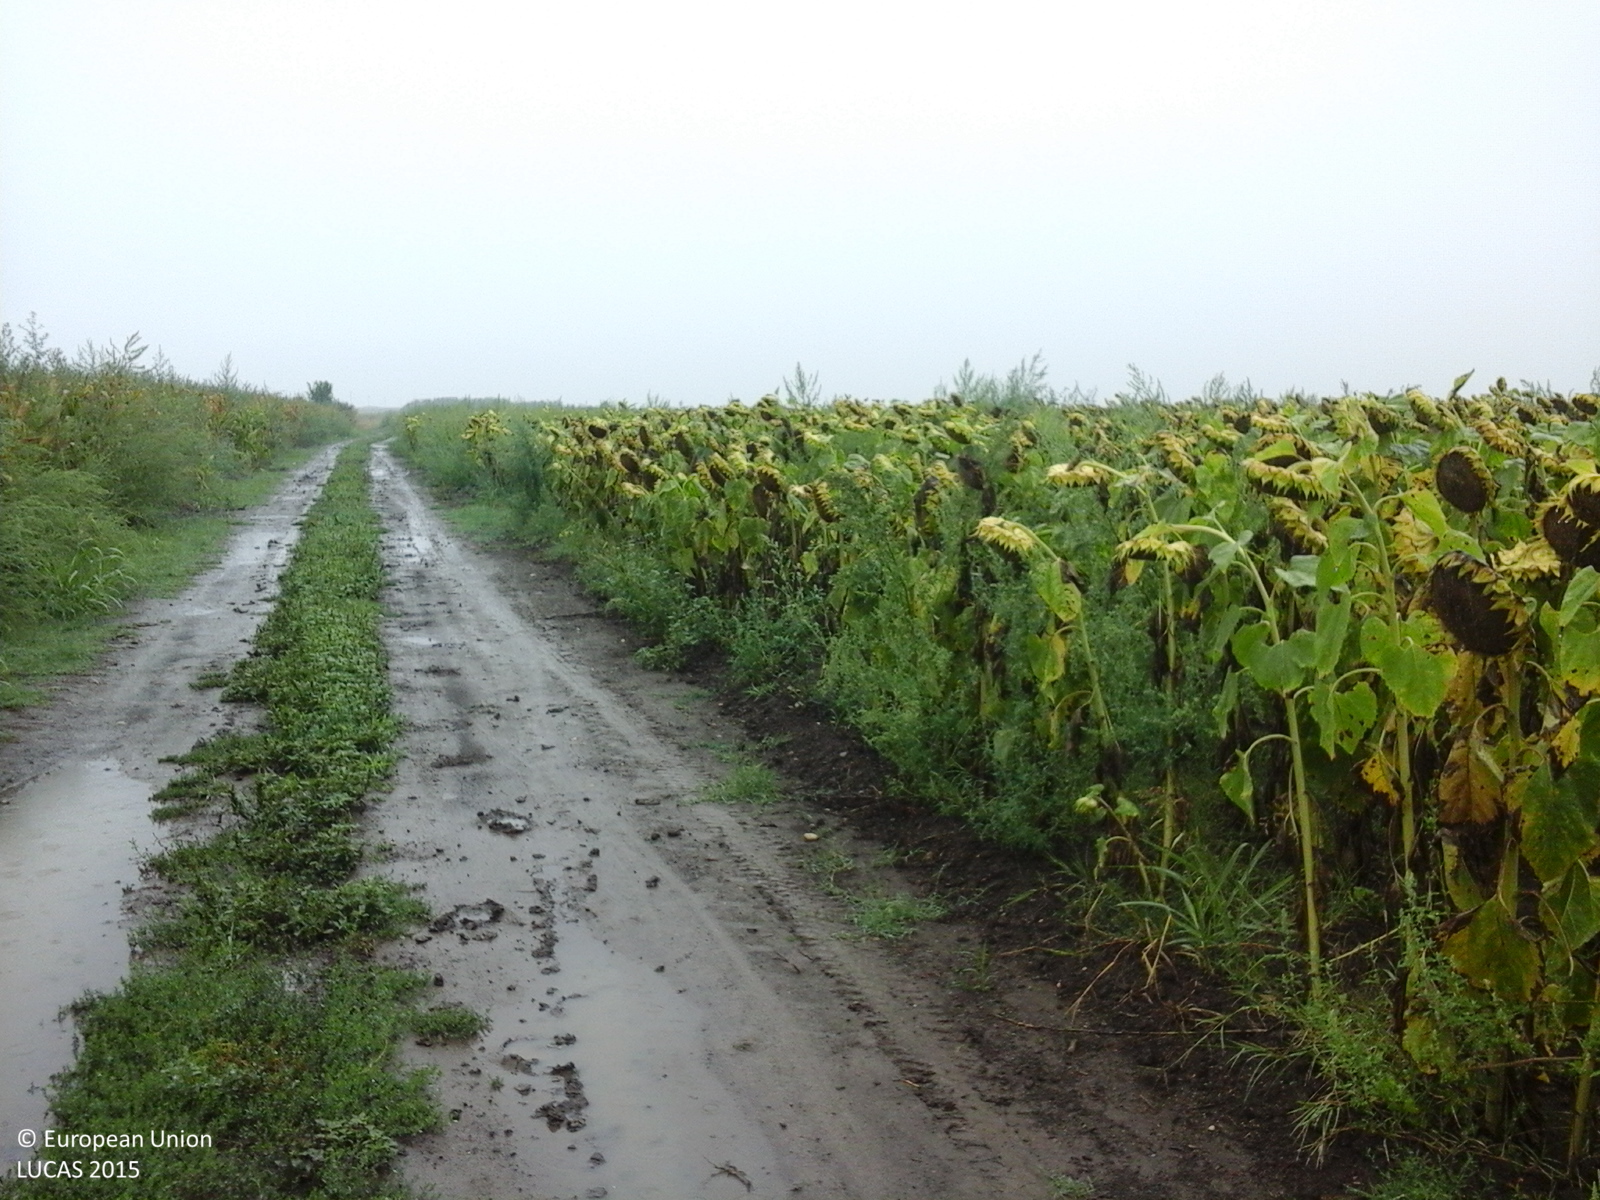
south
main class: Cropland
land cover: Sunflower
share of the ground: > 75 %
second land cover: Spontaneously vegetated surfaces
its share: 25 - 50 %
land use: Agriculture (excluding fallow land and kitchen gardens)
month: August
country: RO
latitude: 45.5864
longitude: 20.9598
